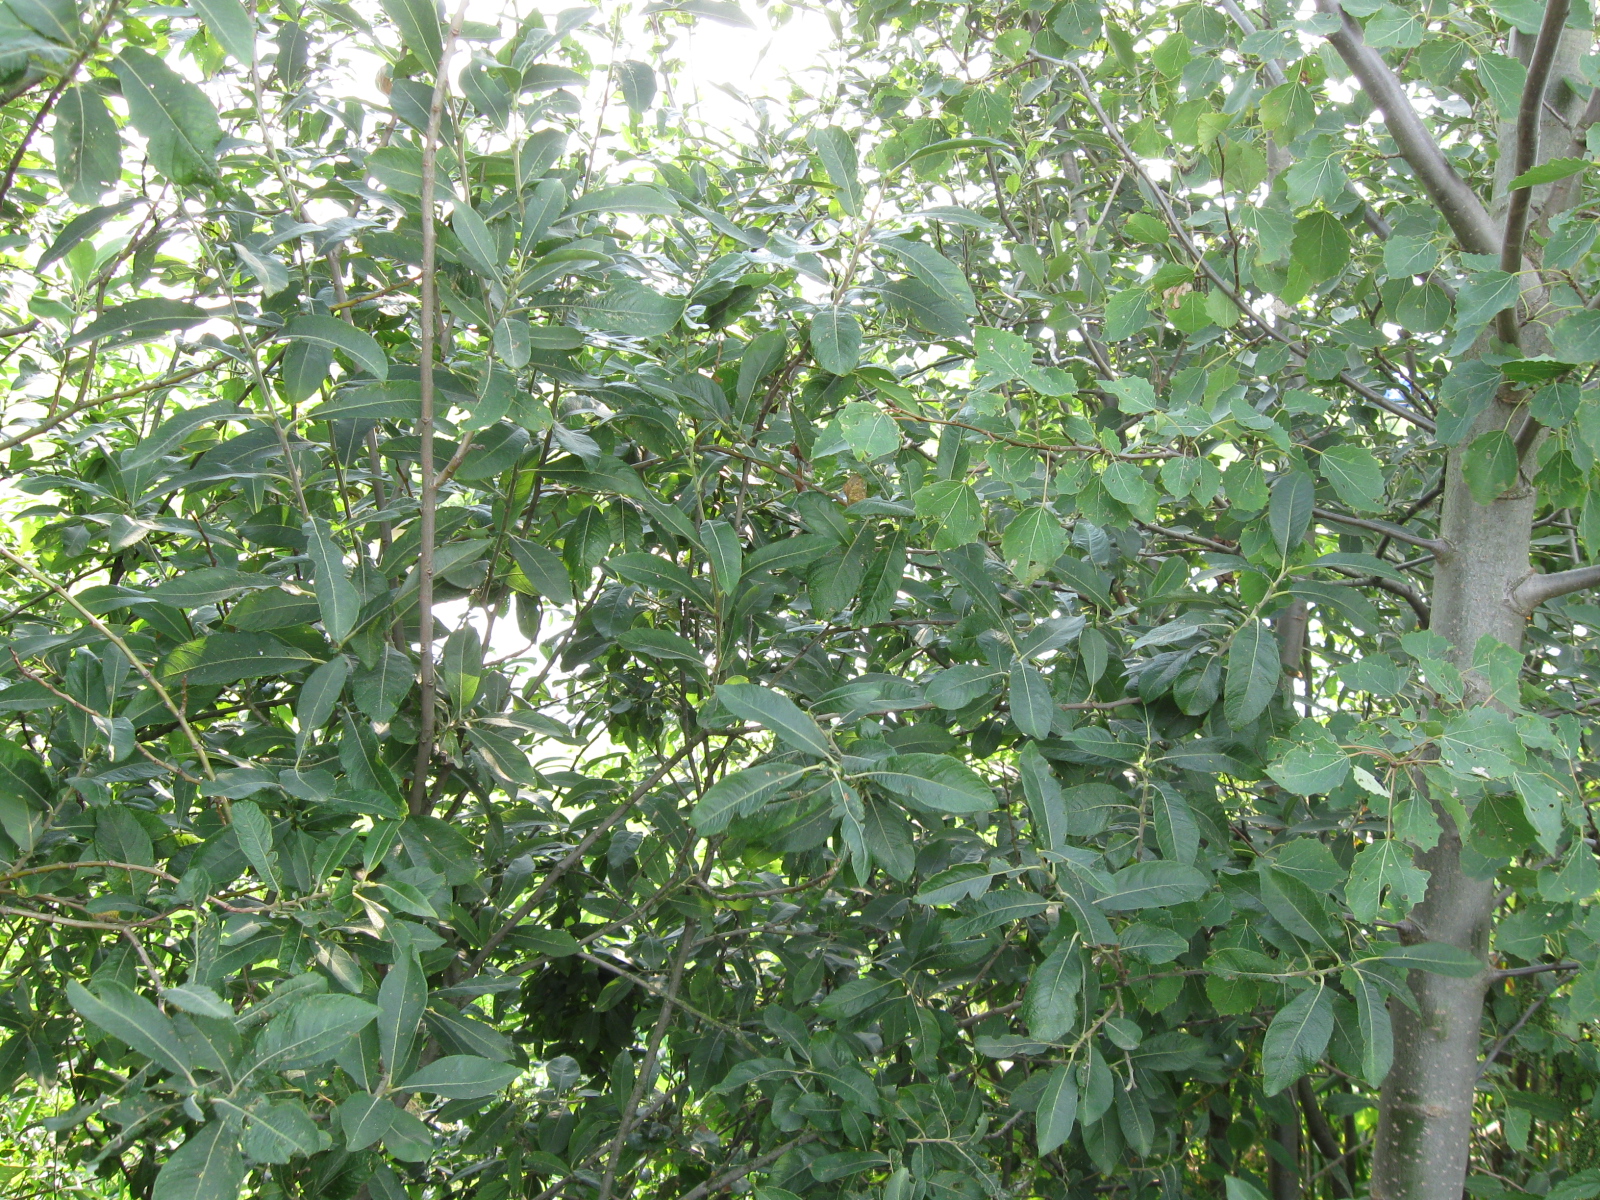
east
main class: Woodland
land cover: Broadleaved woodland
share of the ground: 50 - 75 %
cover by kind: broadleaved forest trees 60 %, shrubs 20 %, herbaceous plants 20 %
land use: Semi-natural and natural areas not in use
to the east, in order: Broadleaved woodland; Ditches and canals; Grassland without tree/shrub cover; Inland fresh water bodies; Grassland with sparse tree/shrub cover; Grassland without tree/shrub cover; Lines of trees; Grass margins; Tracks; Grass margins; Common wheat
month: August
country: LT
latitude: 54.5442
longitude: 23.4521
